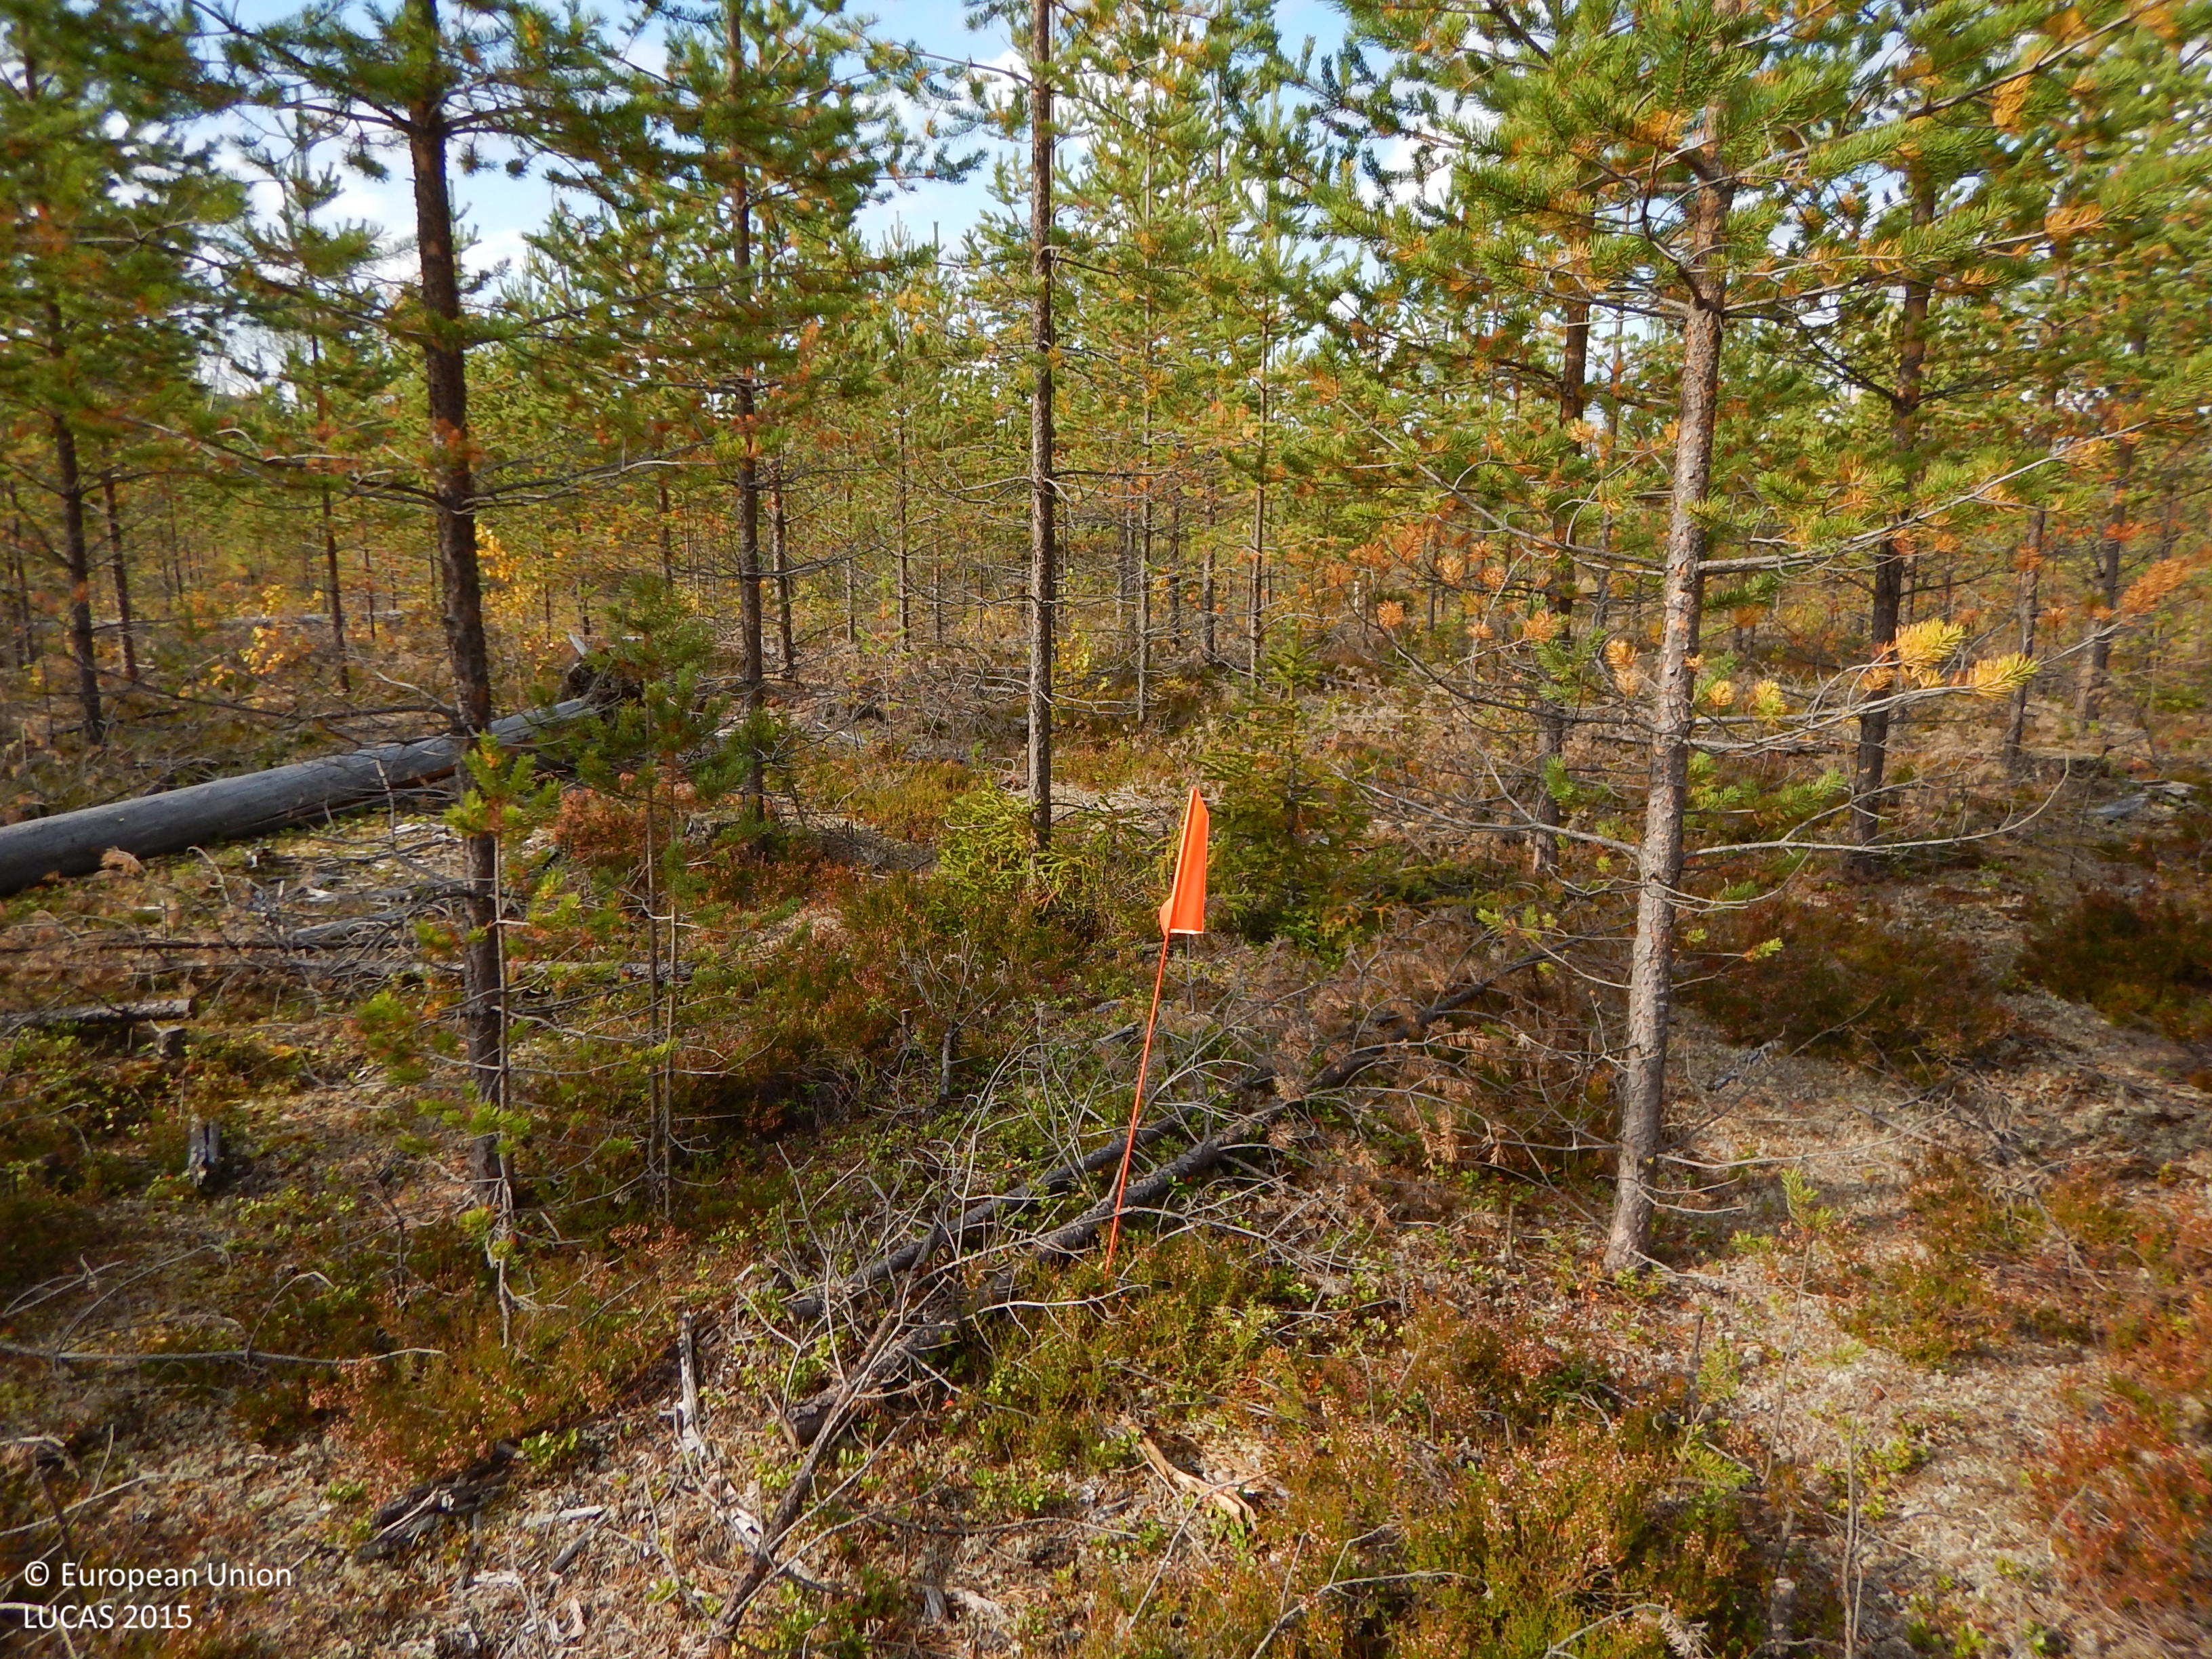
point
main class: Woodland
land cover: Pine dominated coniferous woodland
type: boreal forest
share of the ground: 25 - 50 %
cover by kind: coniferous forest trees 40 %, lichens and mosses 25 %, unconsolidated bare surface 15 %, herbaceous plants 10 %, broadleaved forest trees 5 %, shrubs 5 %
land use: Forestry
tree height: < 5 m
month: September
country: SE
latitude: 64.8150
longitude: 20.2292
